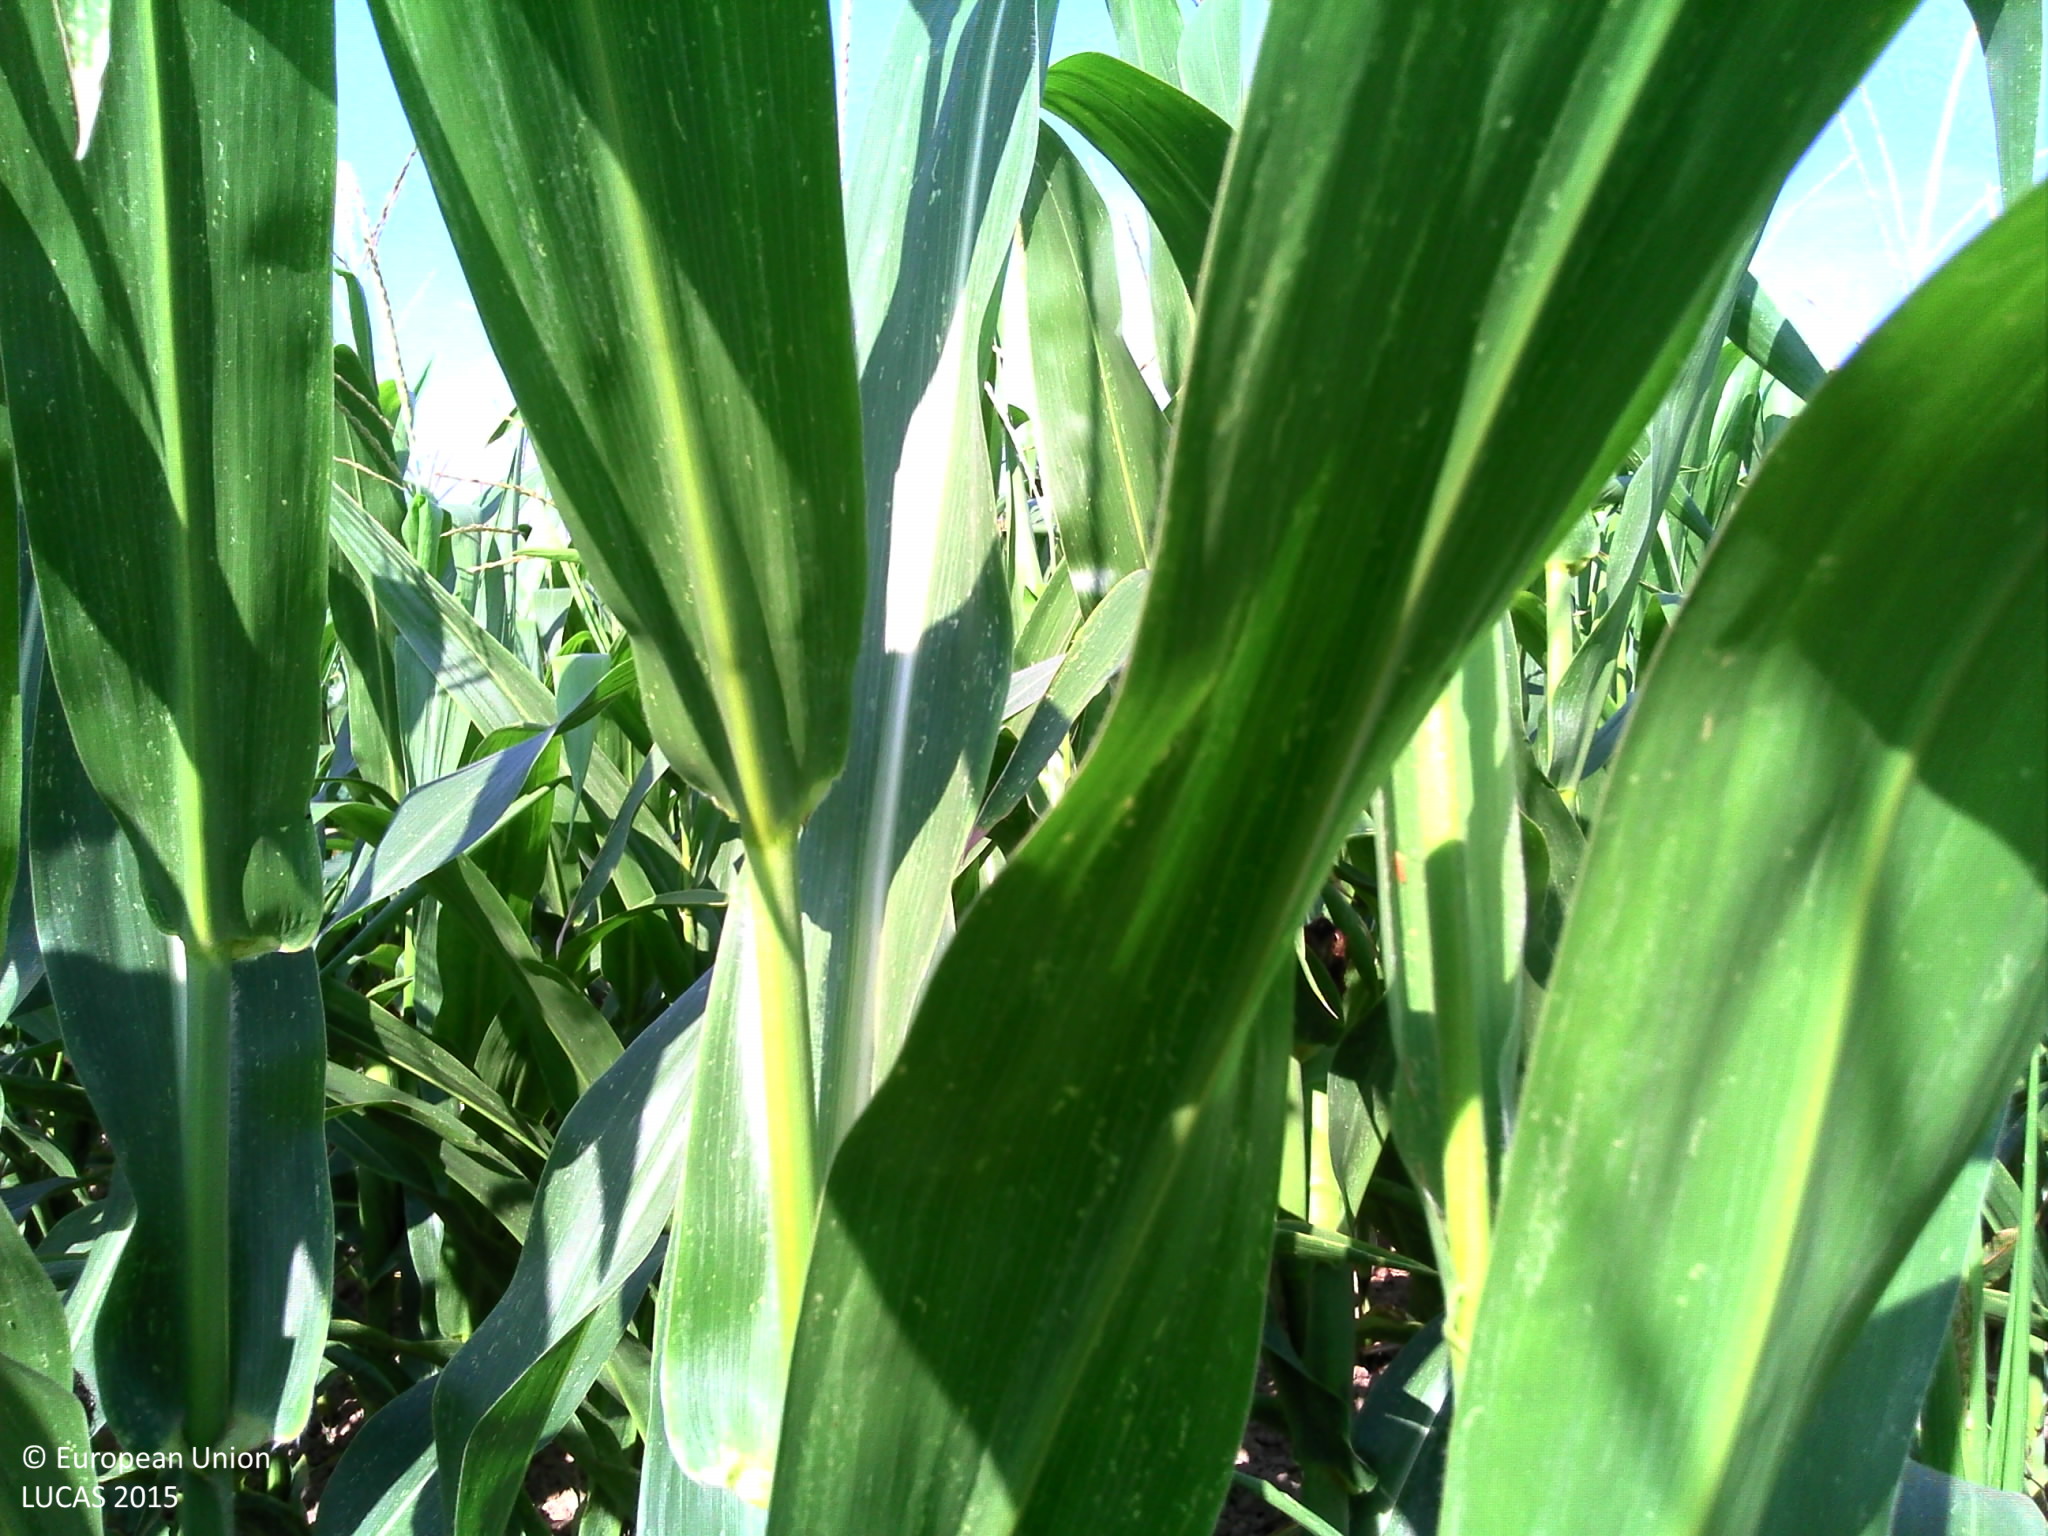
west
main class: Cropland
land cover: Maize
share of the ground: > 75 %
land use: Agriculture (excluding fallow land and kitchen gardens)
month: August
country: FR
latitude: 44.7950
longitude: 1.2352
